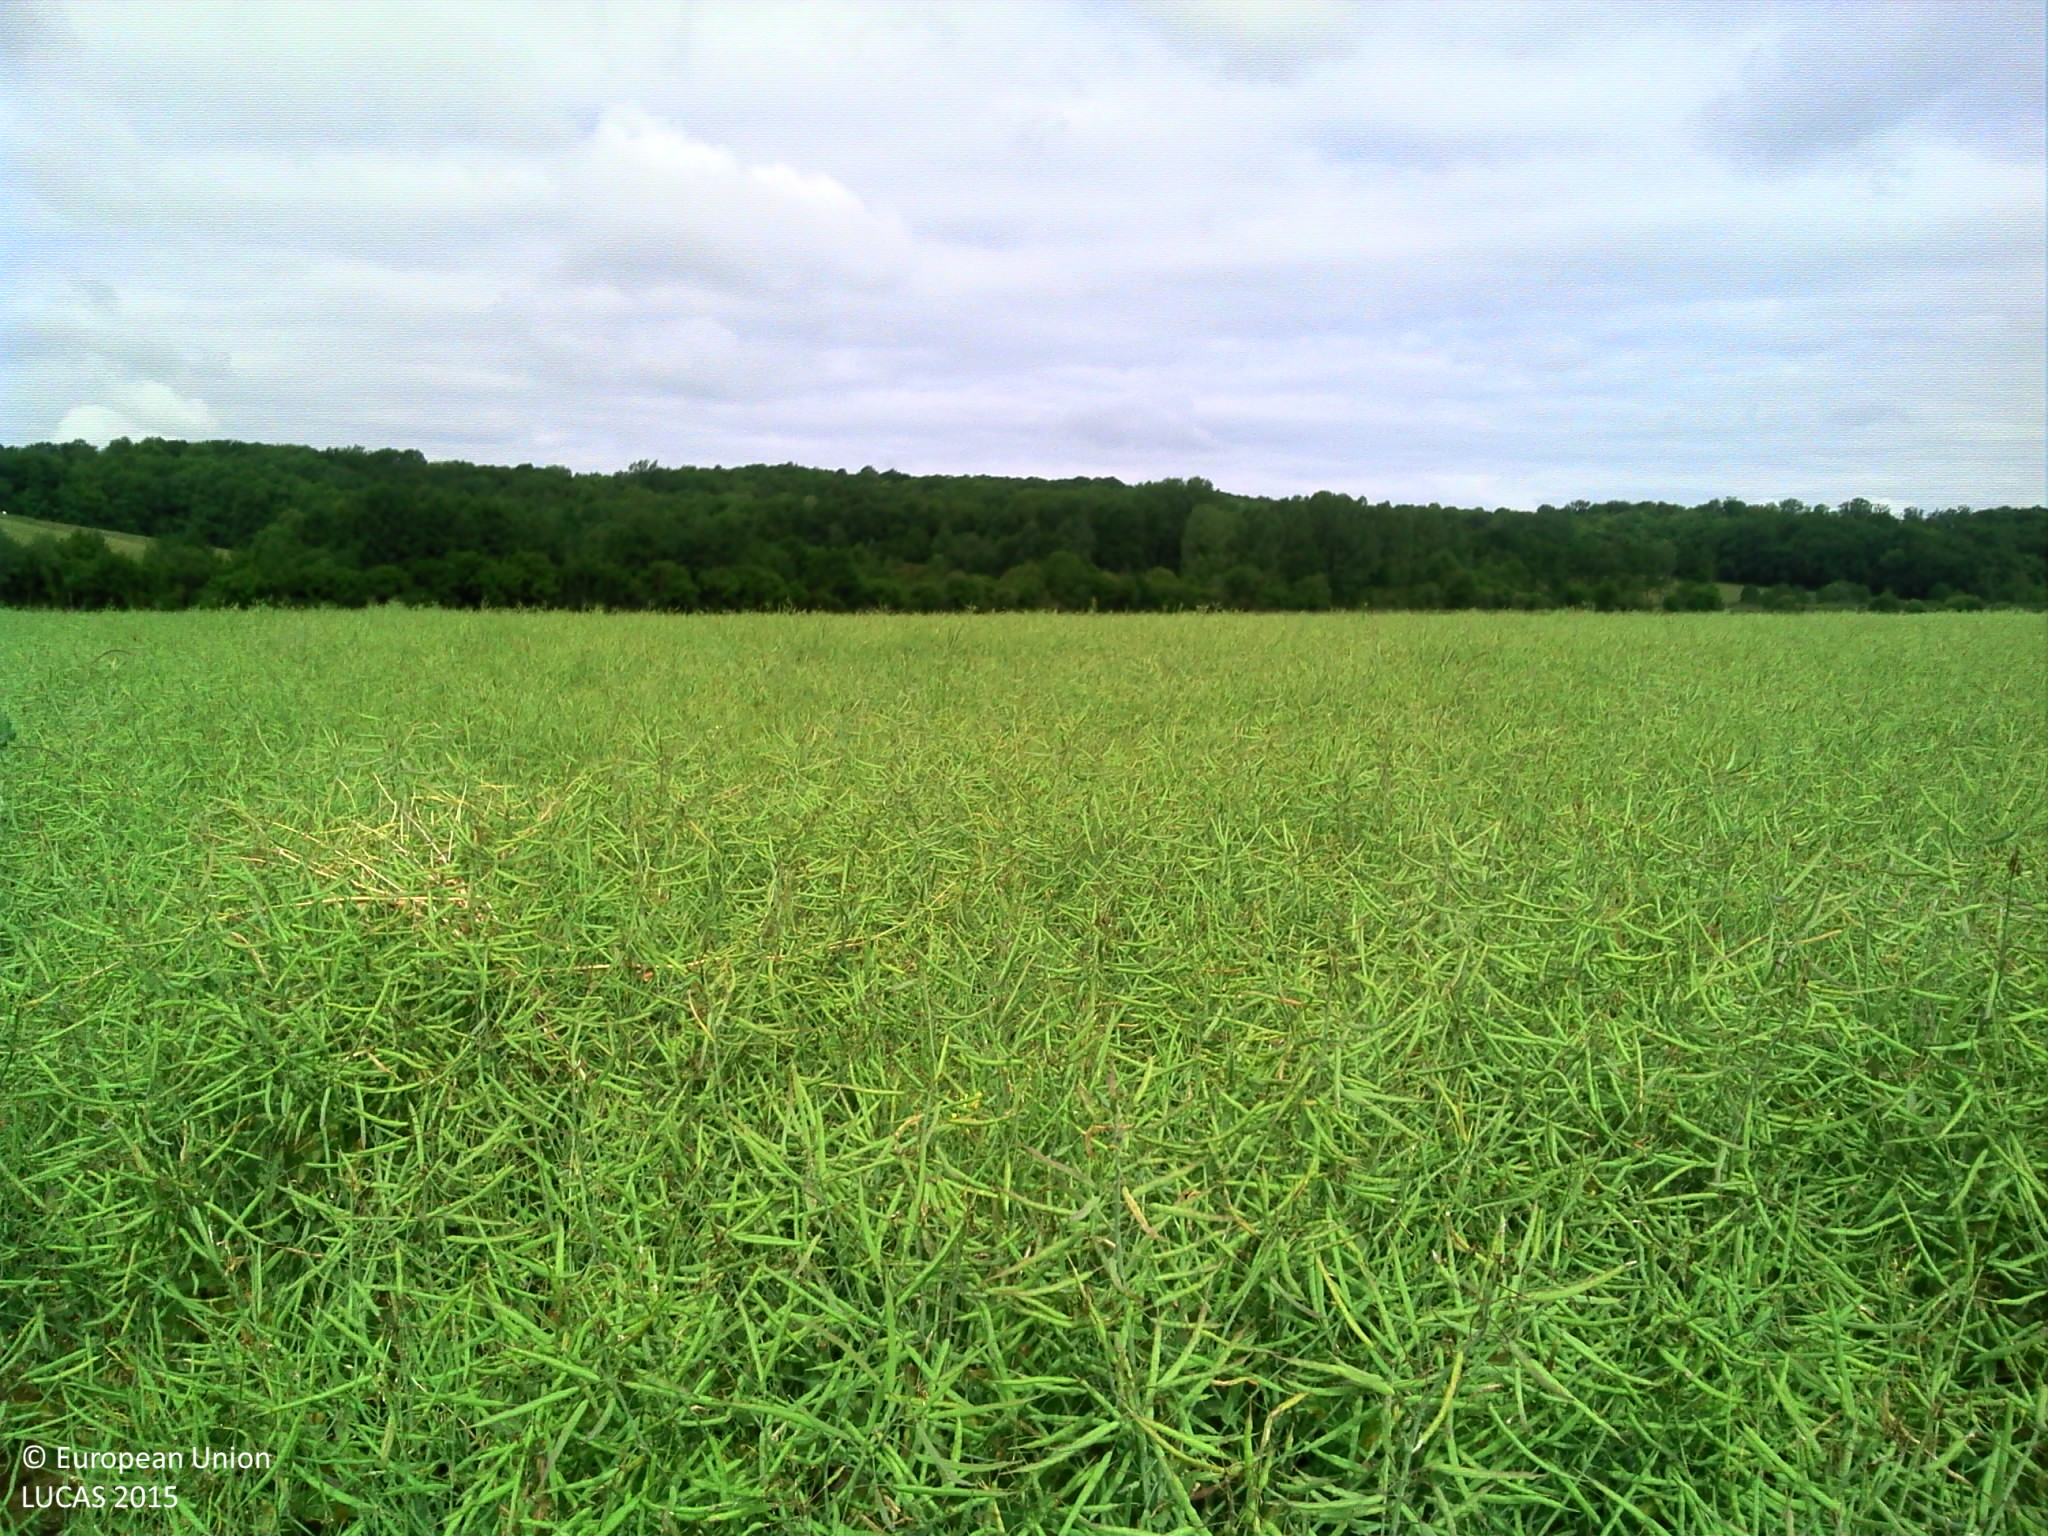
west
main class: Cropland
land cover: Rape and turnip rape
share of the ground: > 75 %
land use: Agriculture (excluding fallow land and kitchen gardens)
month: June
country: FR
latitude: 48.5212
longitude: 4.9210
